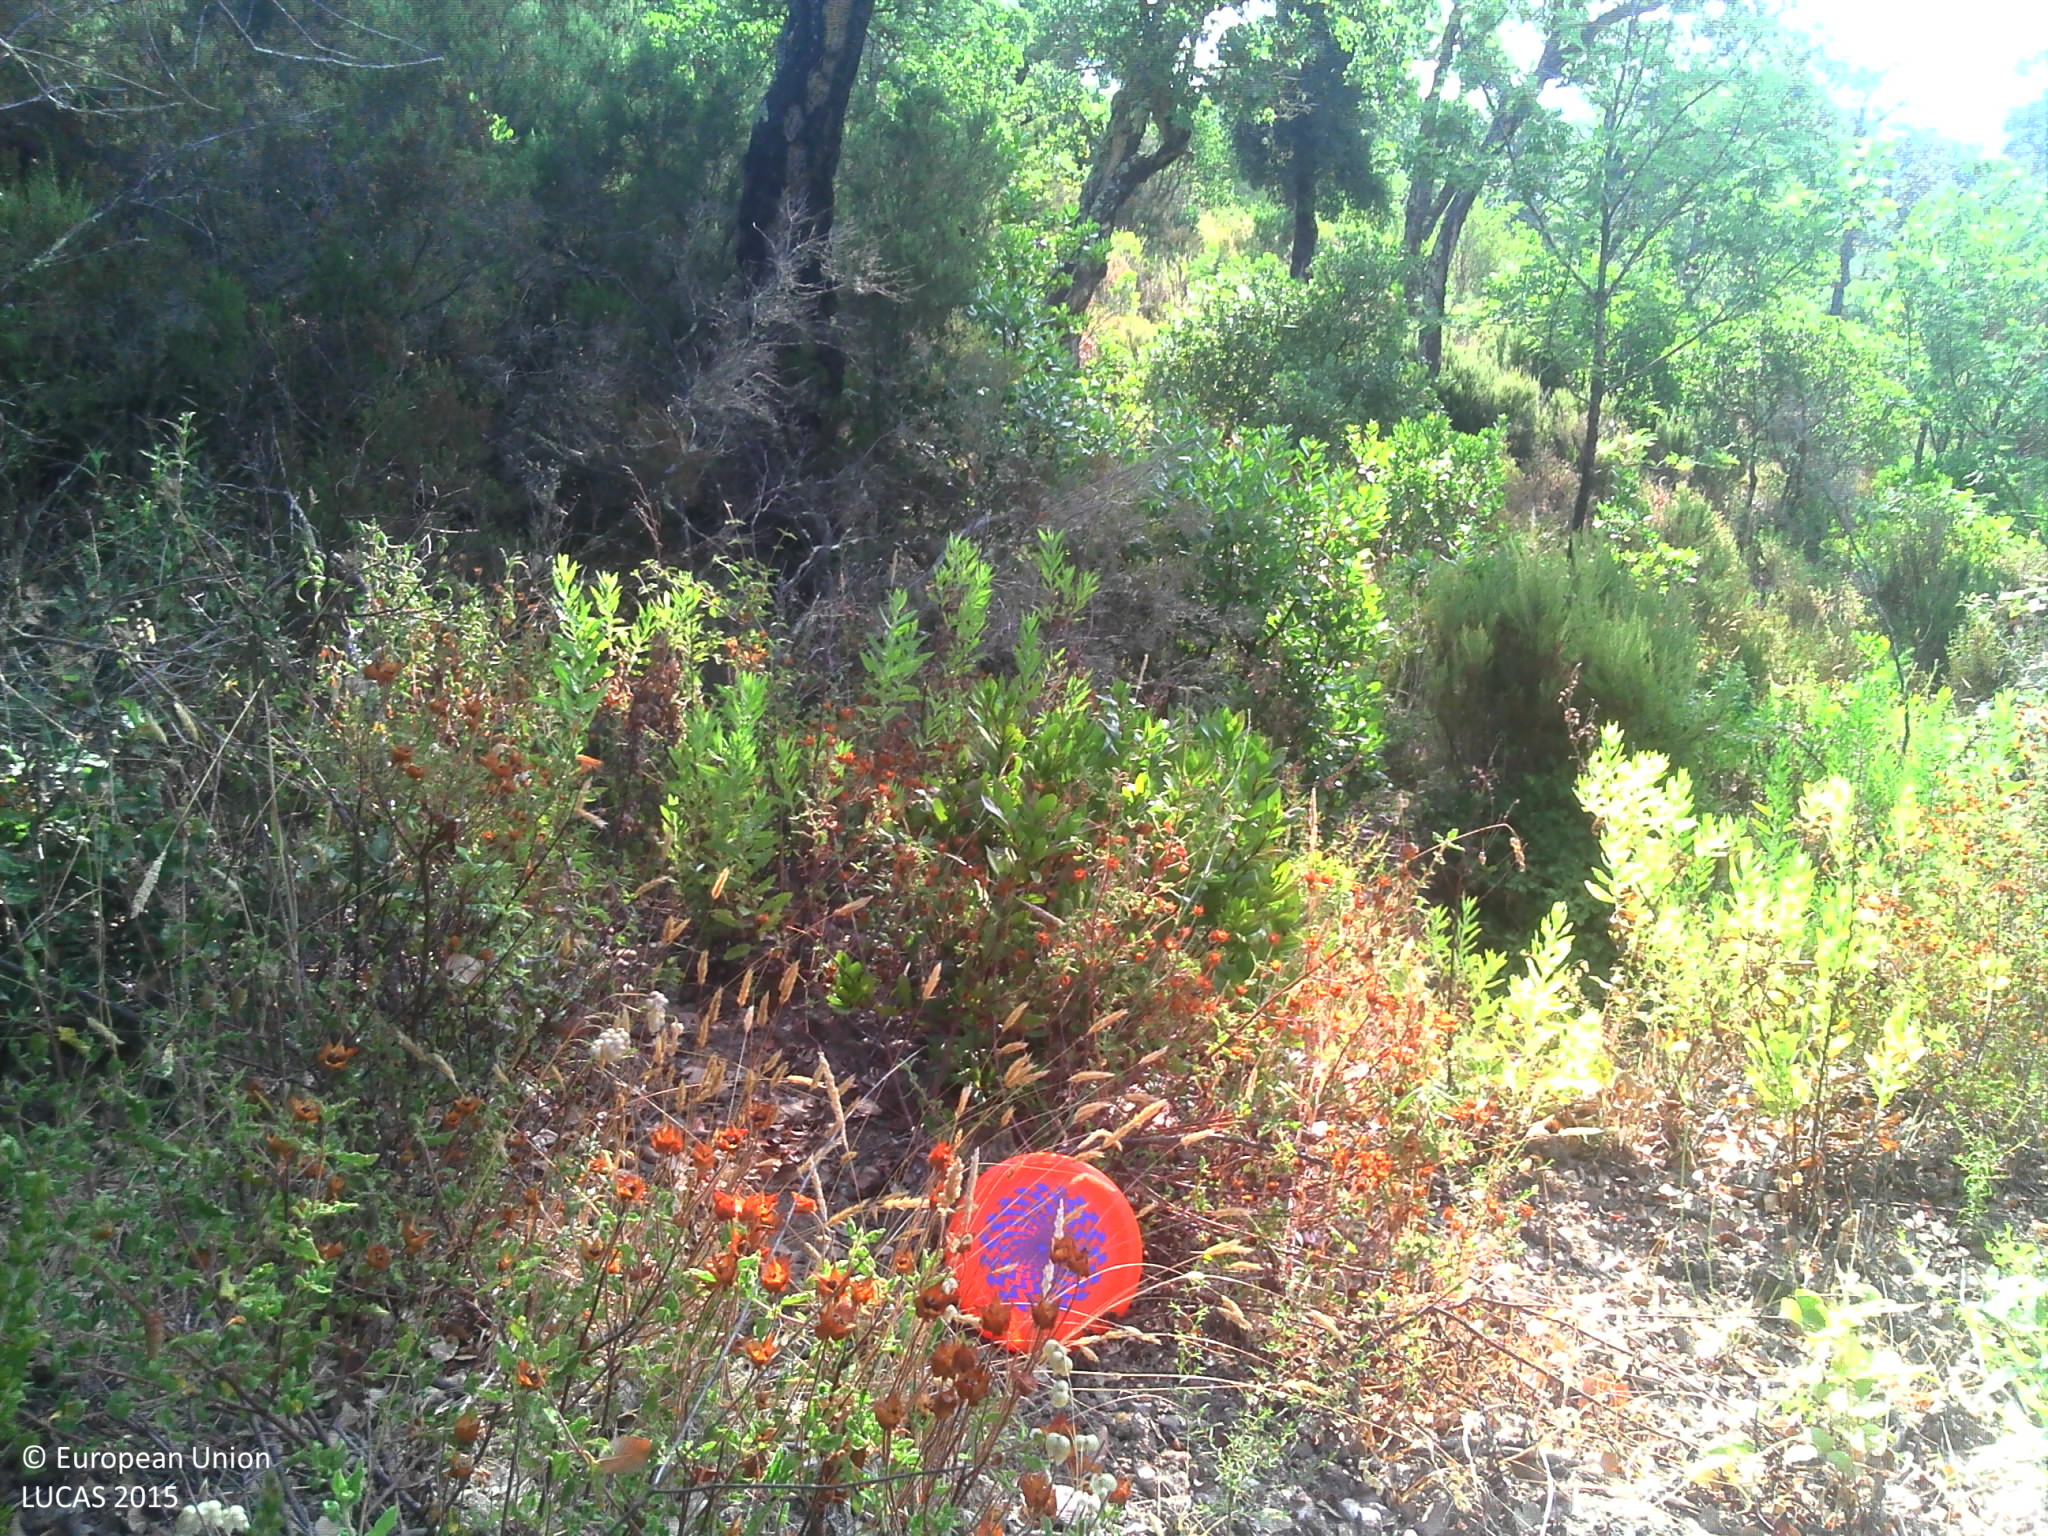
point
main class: Shrubland
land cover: Shrubland with sparse tree cover
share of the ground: > 75 %
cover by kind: shrubs 90 %, broadleaved forest trees 5 %, unconsolidated bare surface 5 %
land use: Semi-natural and natural areas not in use
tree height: < 5 m
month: July
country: FR
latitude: 43.1849
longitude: 6.3553
